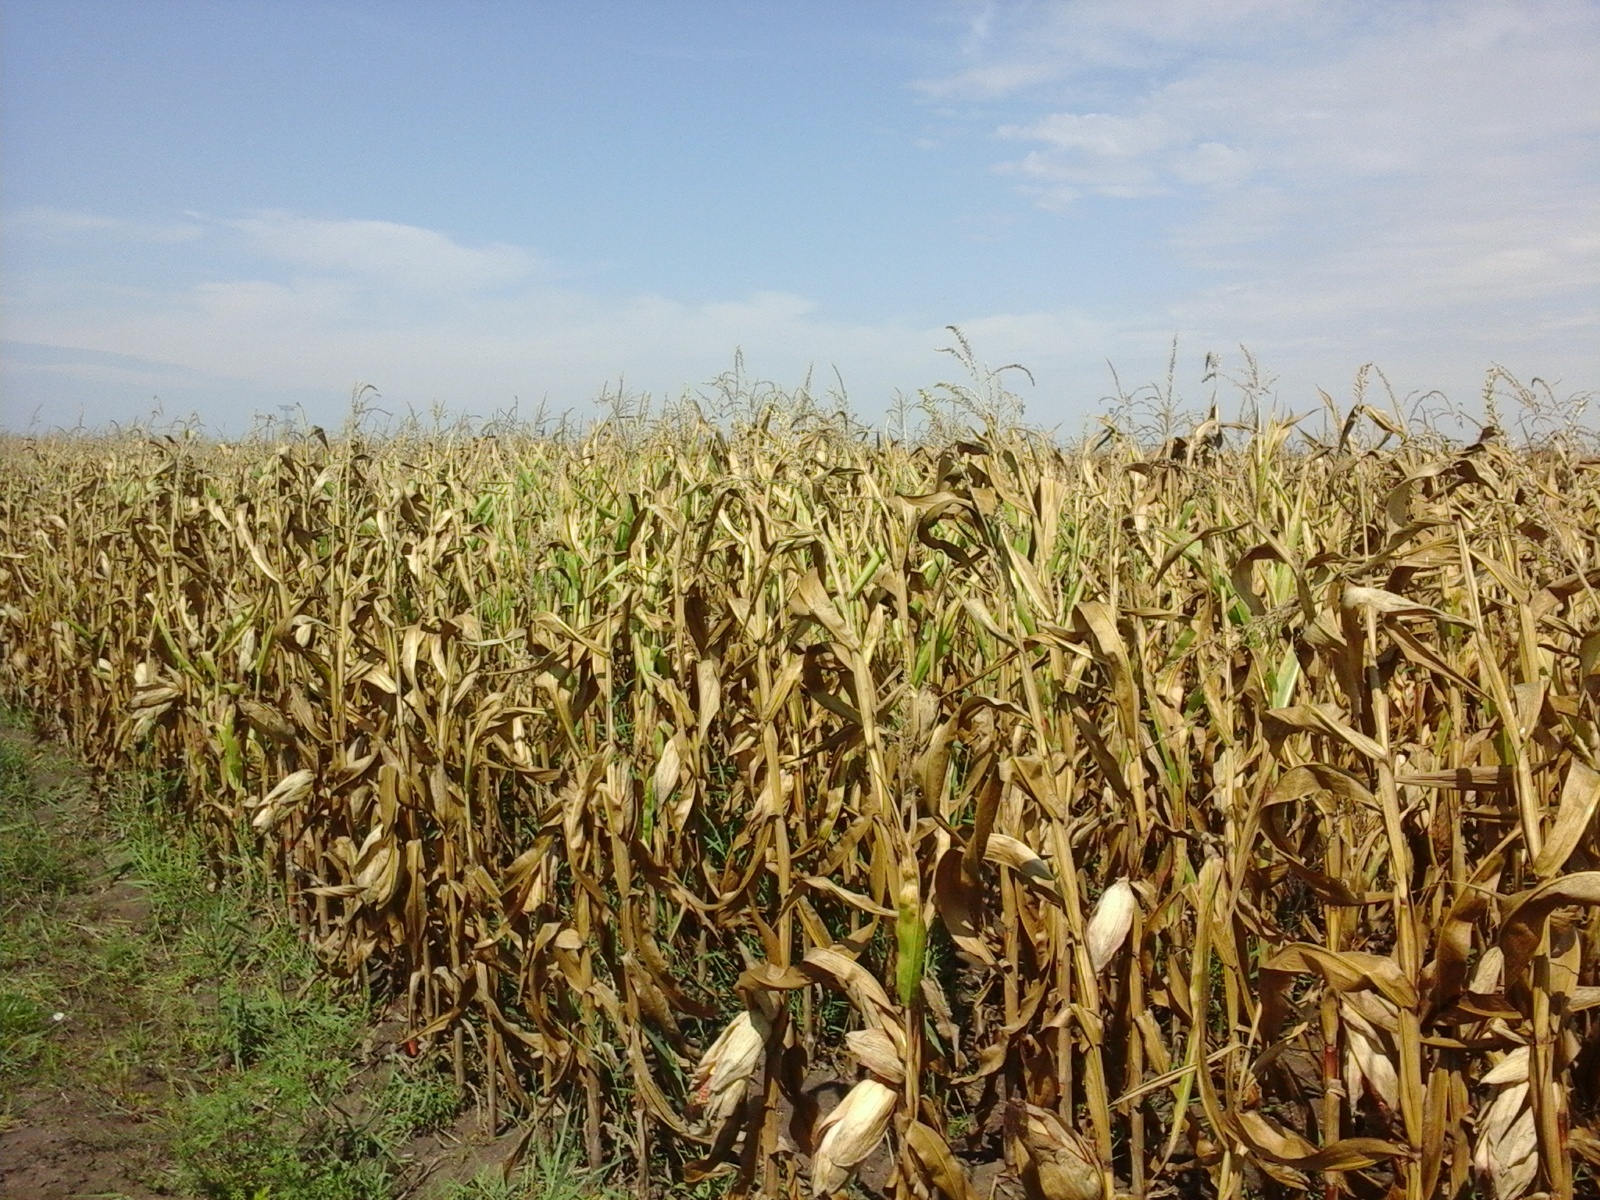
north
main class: Cropland
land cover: Maize
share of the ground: > 75 %
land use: Agriculture (excluding fallow land and kitchen gardens)
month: August
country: RO
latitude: 46.4718
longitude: 21.3533
